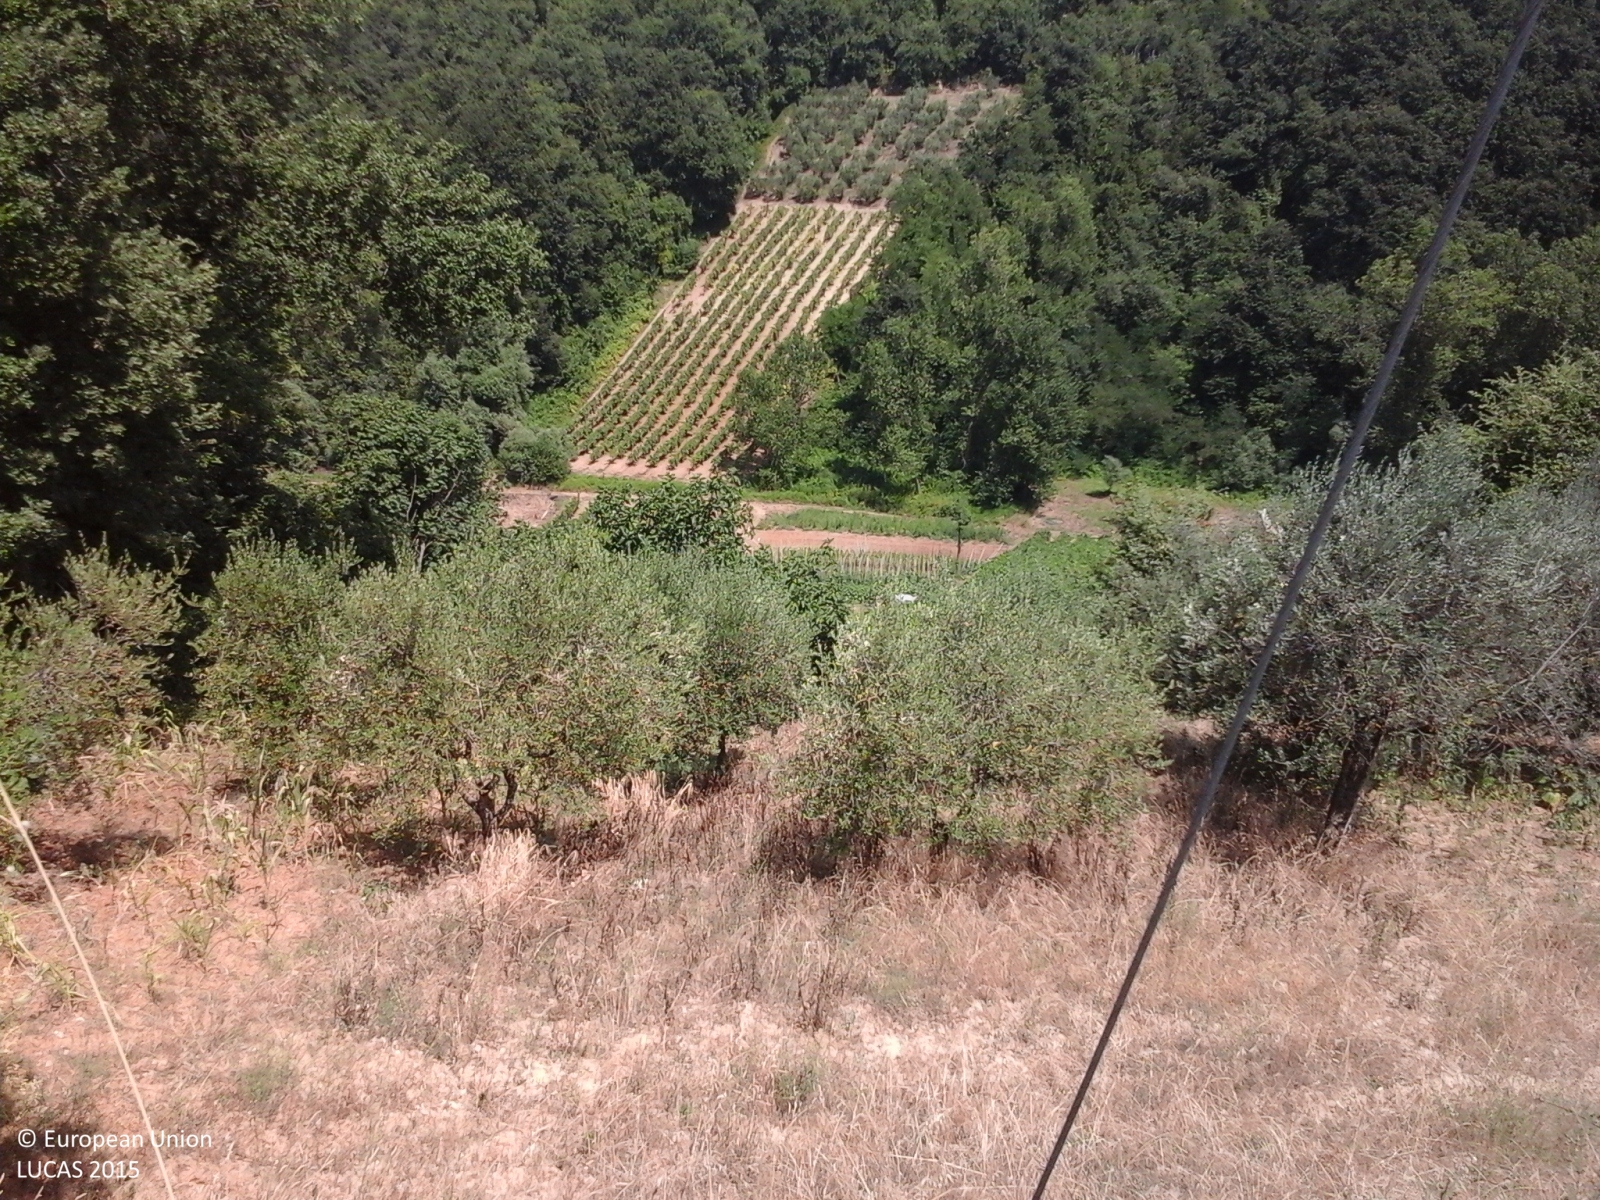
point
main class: Cropland
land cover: Tomatoes
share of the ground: > 75 %
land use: Agriculture (excluding fallow land and kitchen gardens)
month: July
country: IT
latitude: 42.2577
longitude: 14.2417
